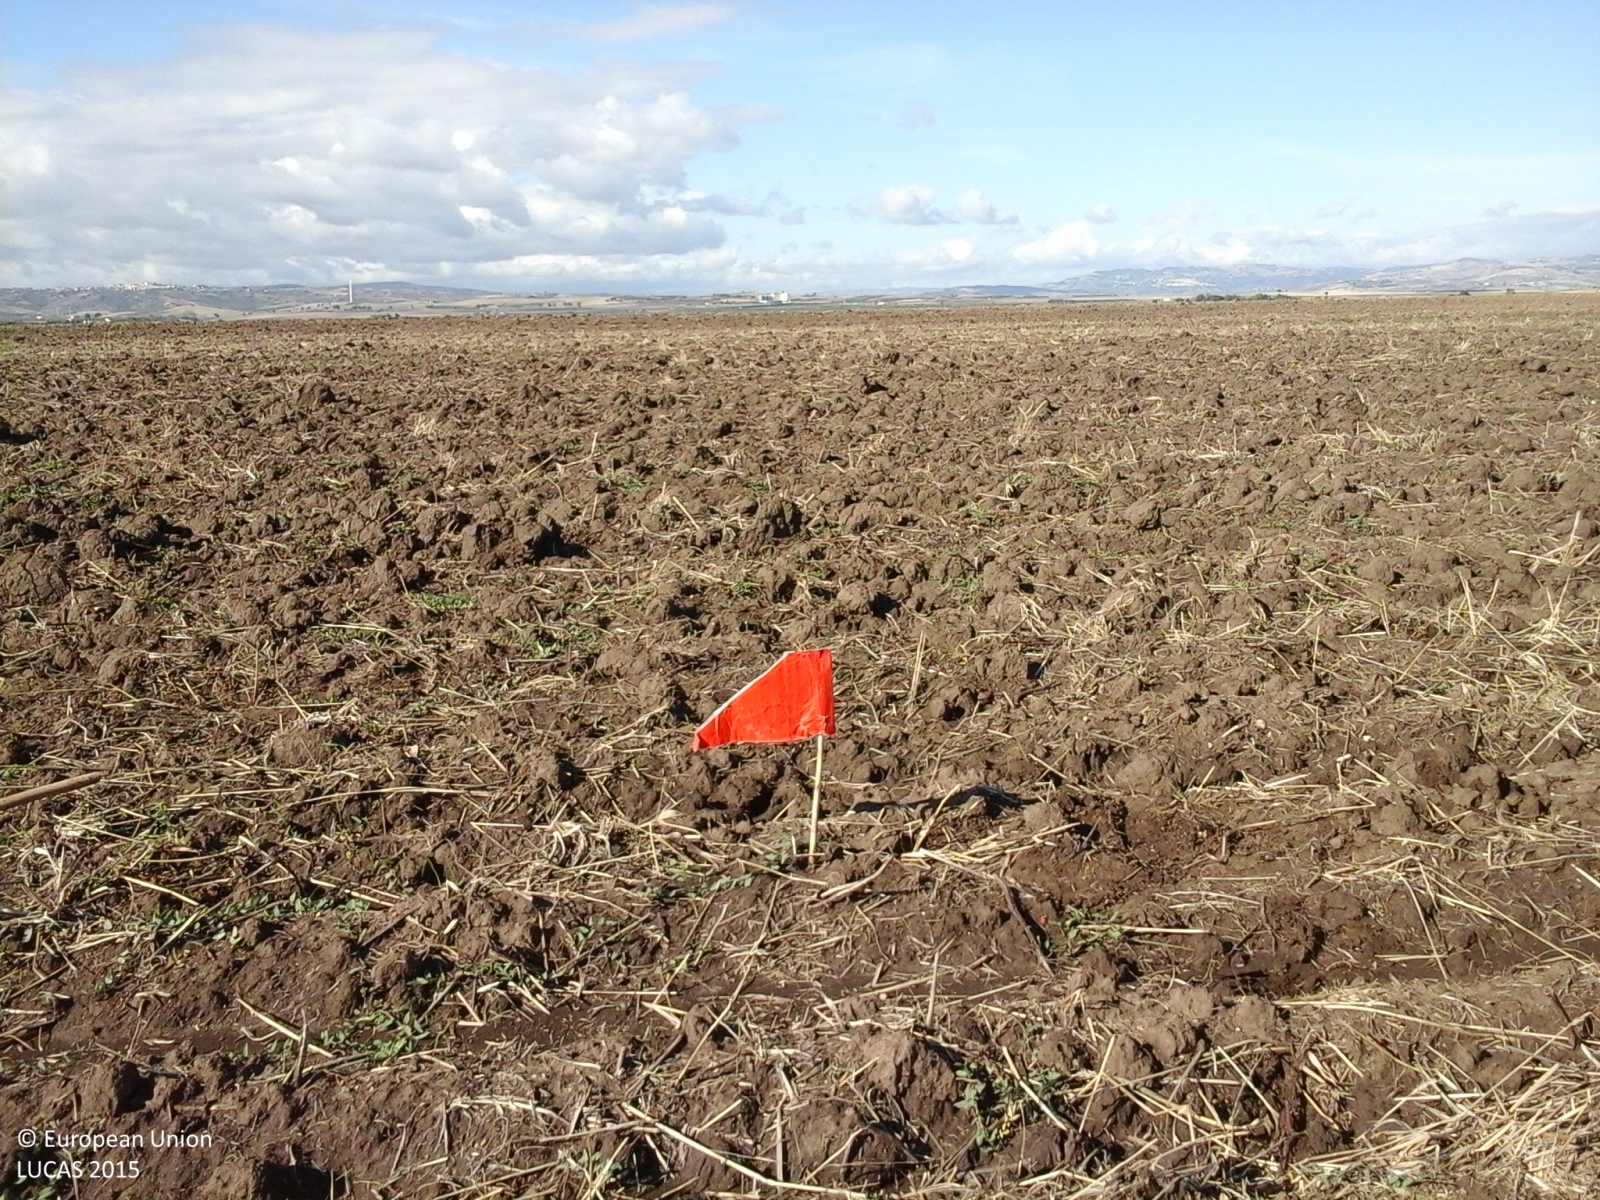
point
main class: Cropland
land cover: Dry pulses
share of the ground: > 75 %
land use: Agriculture (excluding fallow land and kitchen gardens)
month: September
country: IT
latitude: 41.6705
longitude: 15.1840
